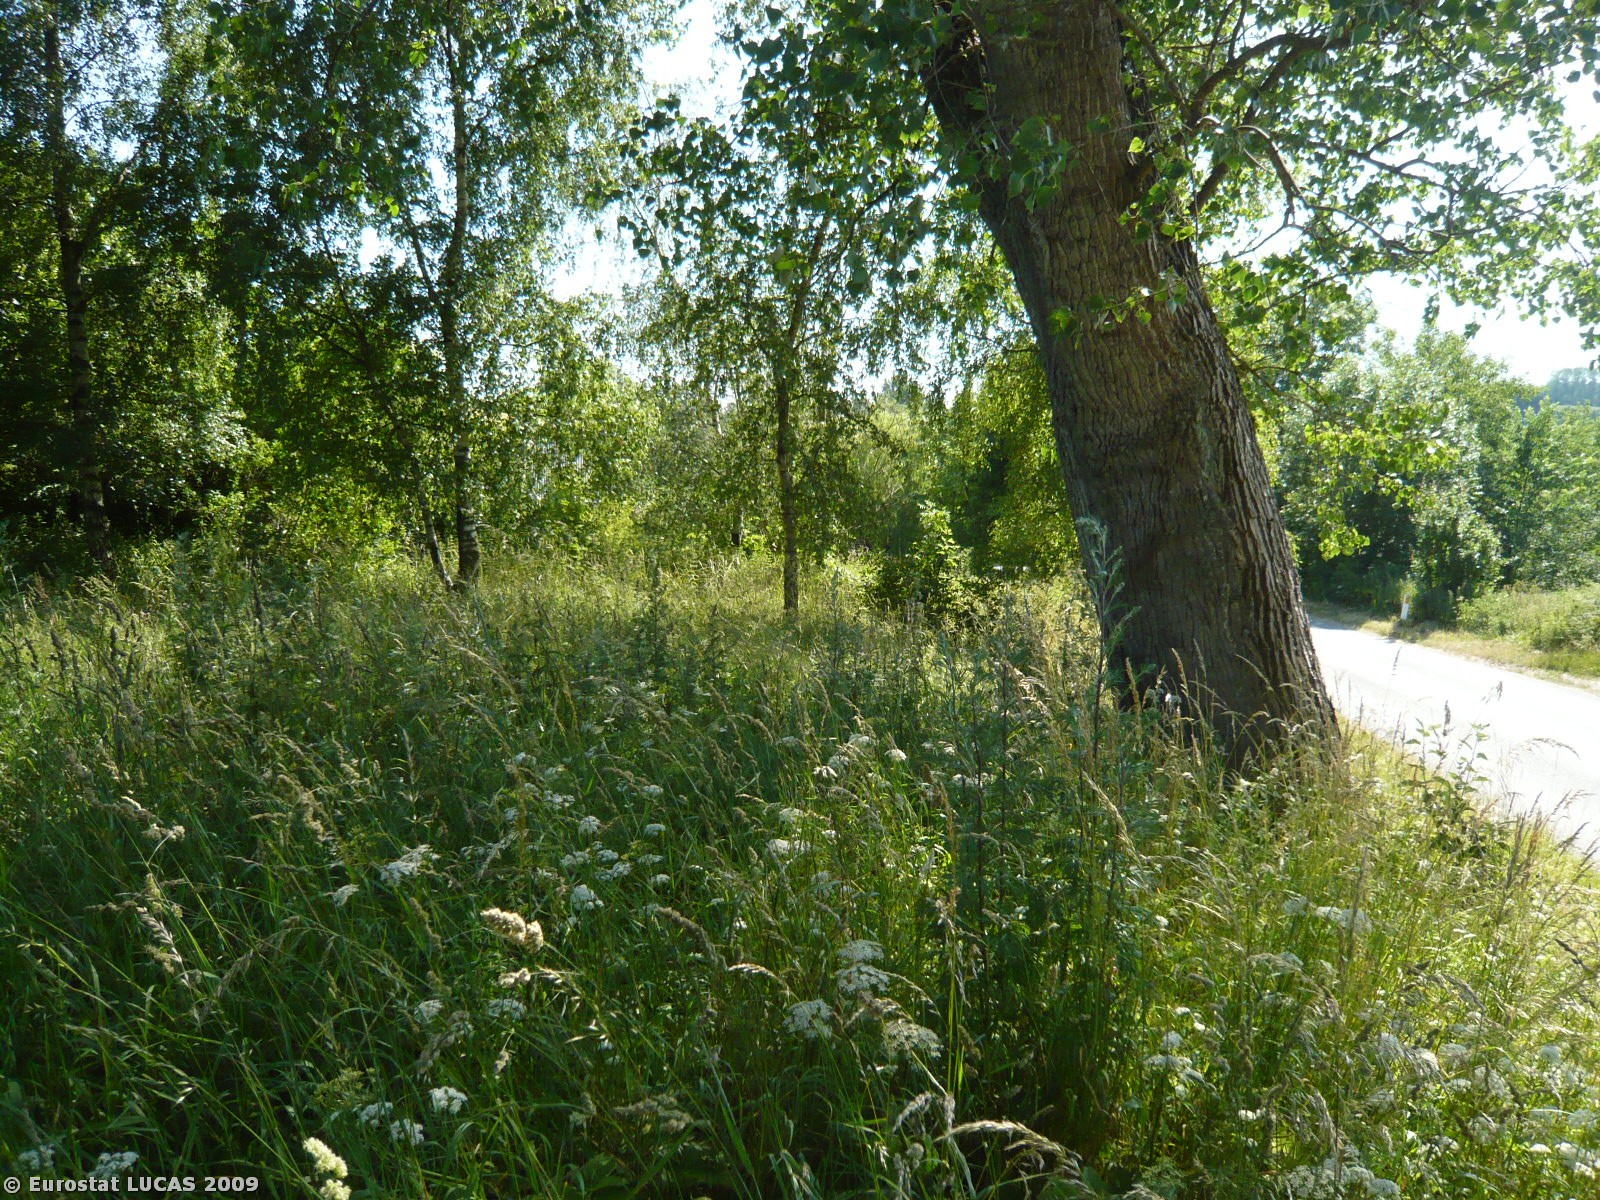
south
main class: Grassland
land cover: Spontaneously vegetated surfaces
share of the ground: > 75 %
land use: Fallow land
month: July
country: DK
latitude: 55.3788
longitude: 10.1734
